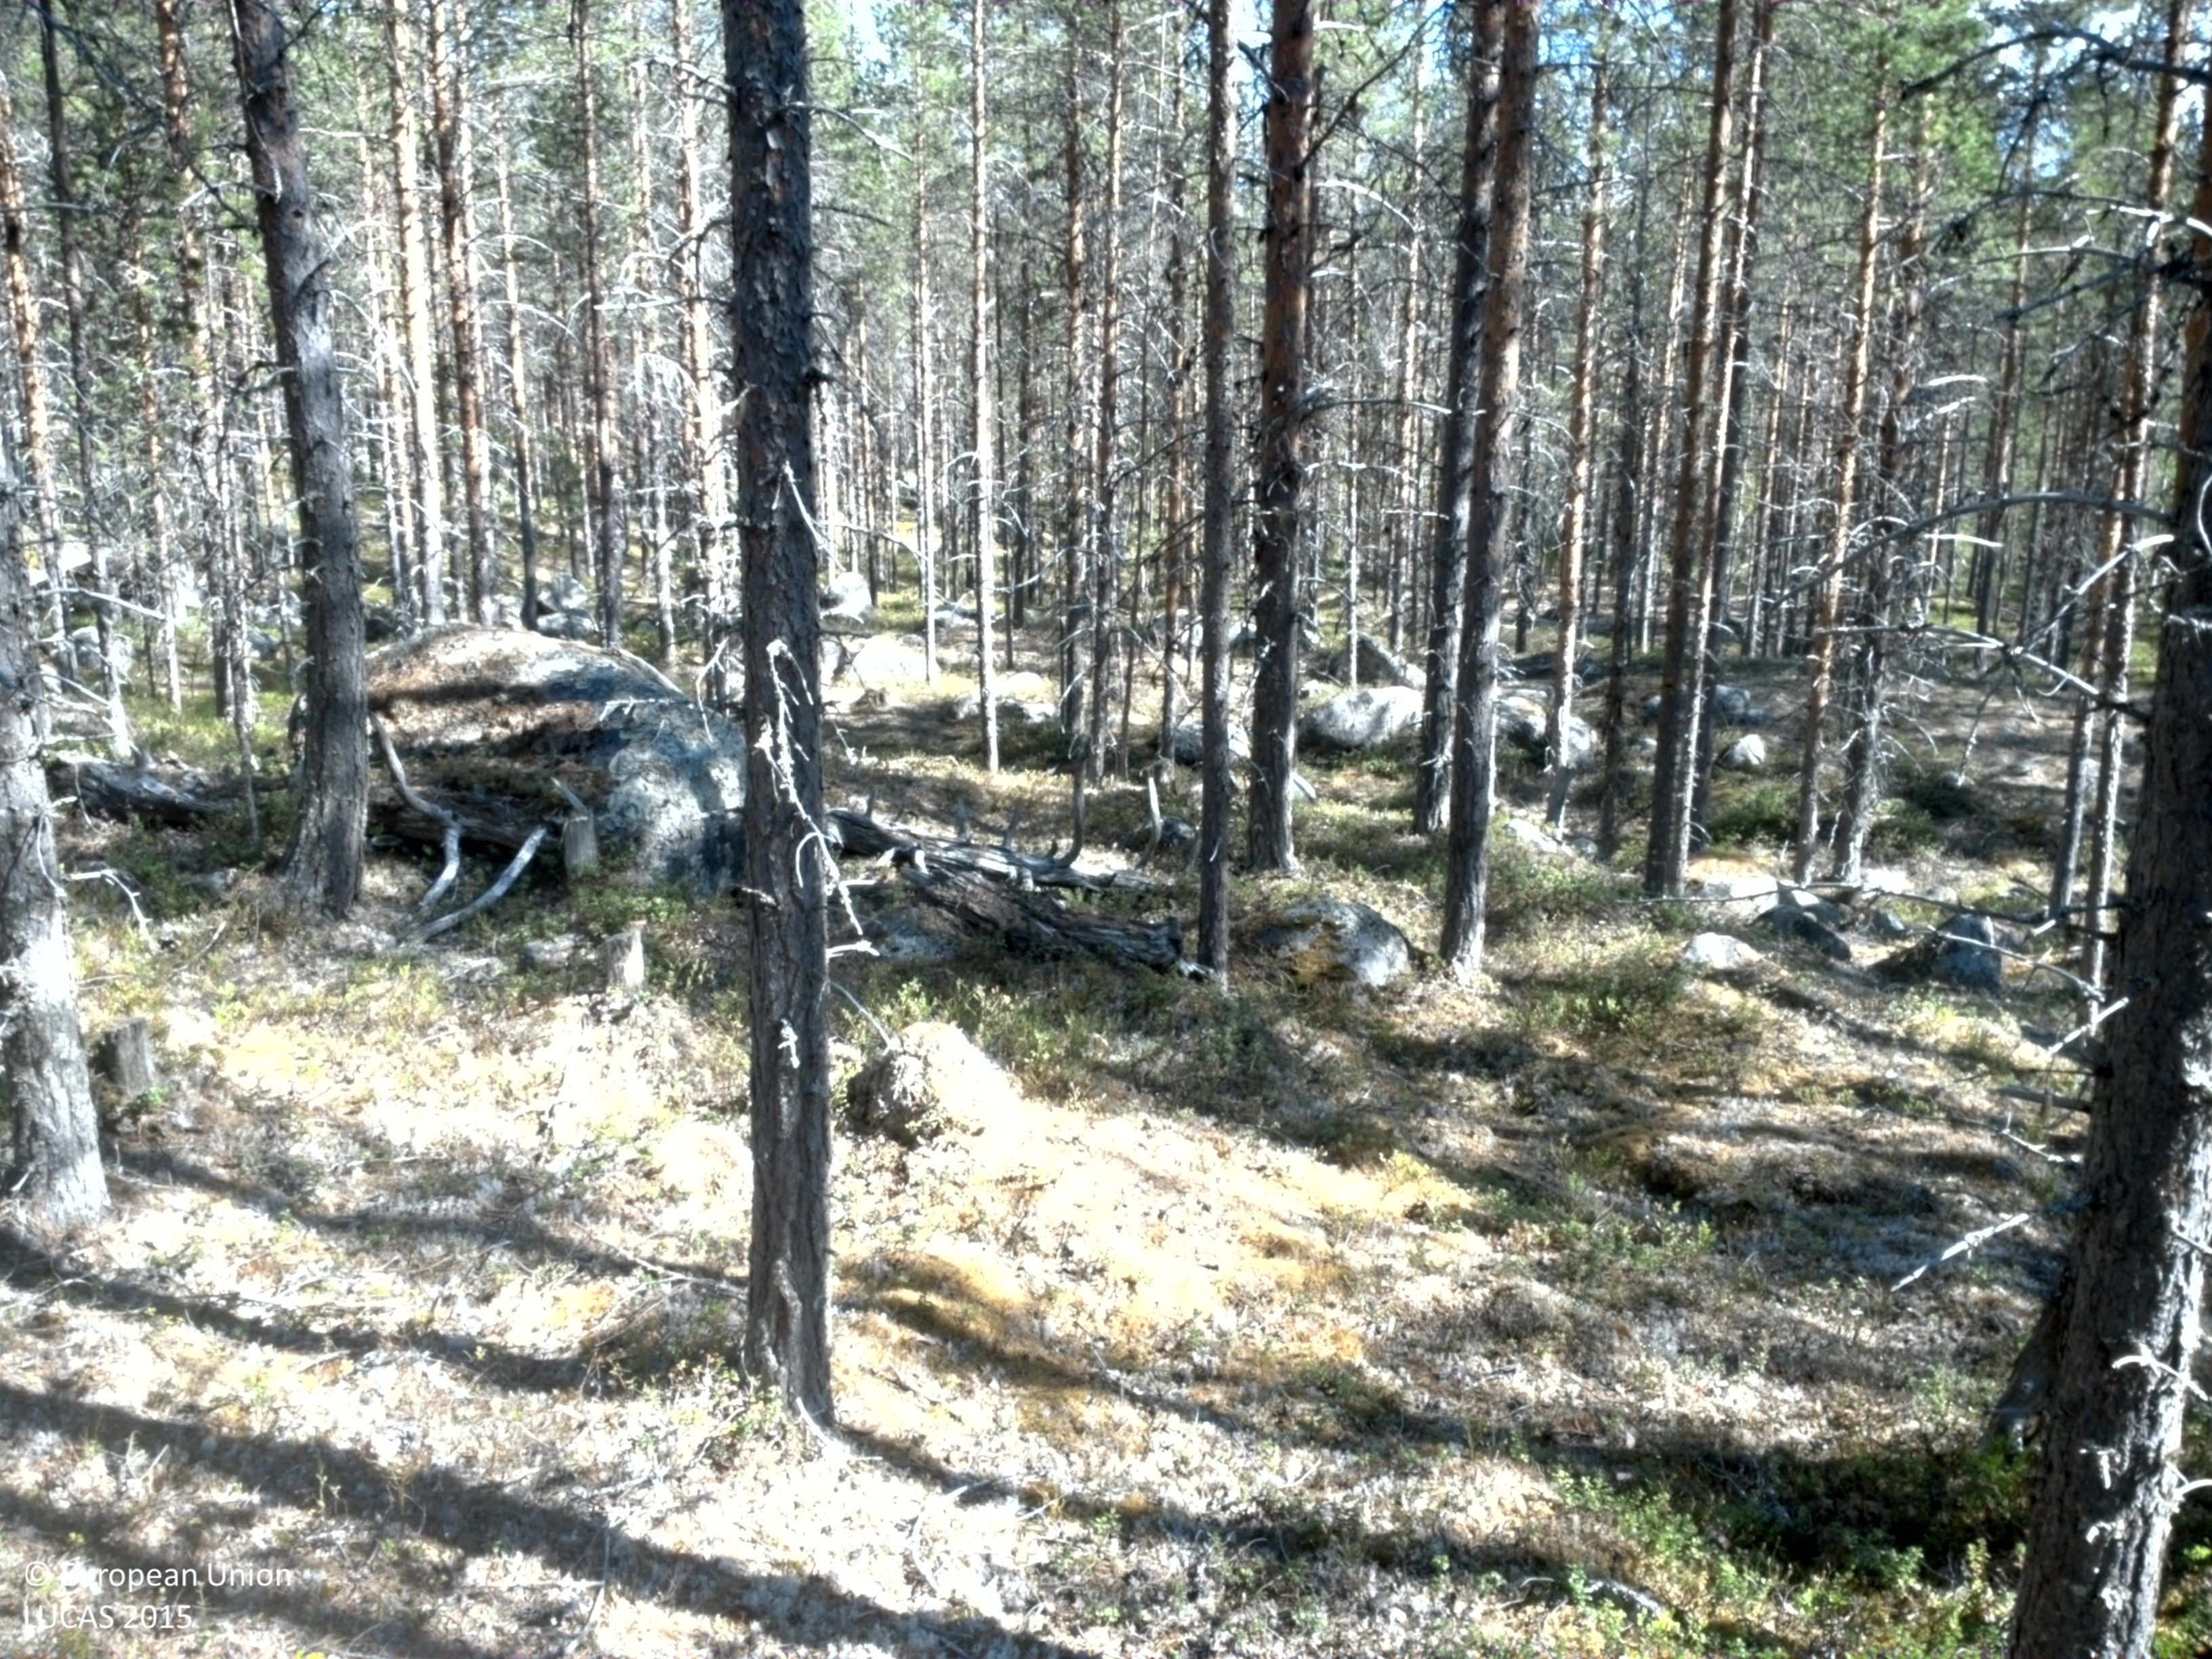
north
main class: Woodland
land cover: Pine dominated coniferous woodland
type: boreal forest
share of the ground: 25 - 50 %
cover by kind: shrubs 45 %, coniferous forest trees 40 %, consolidated bare surface 10 %, lichens and mosses 5 %
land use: Forestry
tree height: > 5 m
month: June
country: SE
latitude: 66.0492
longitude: 19.4274
